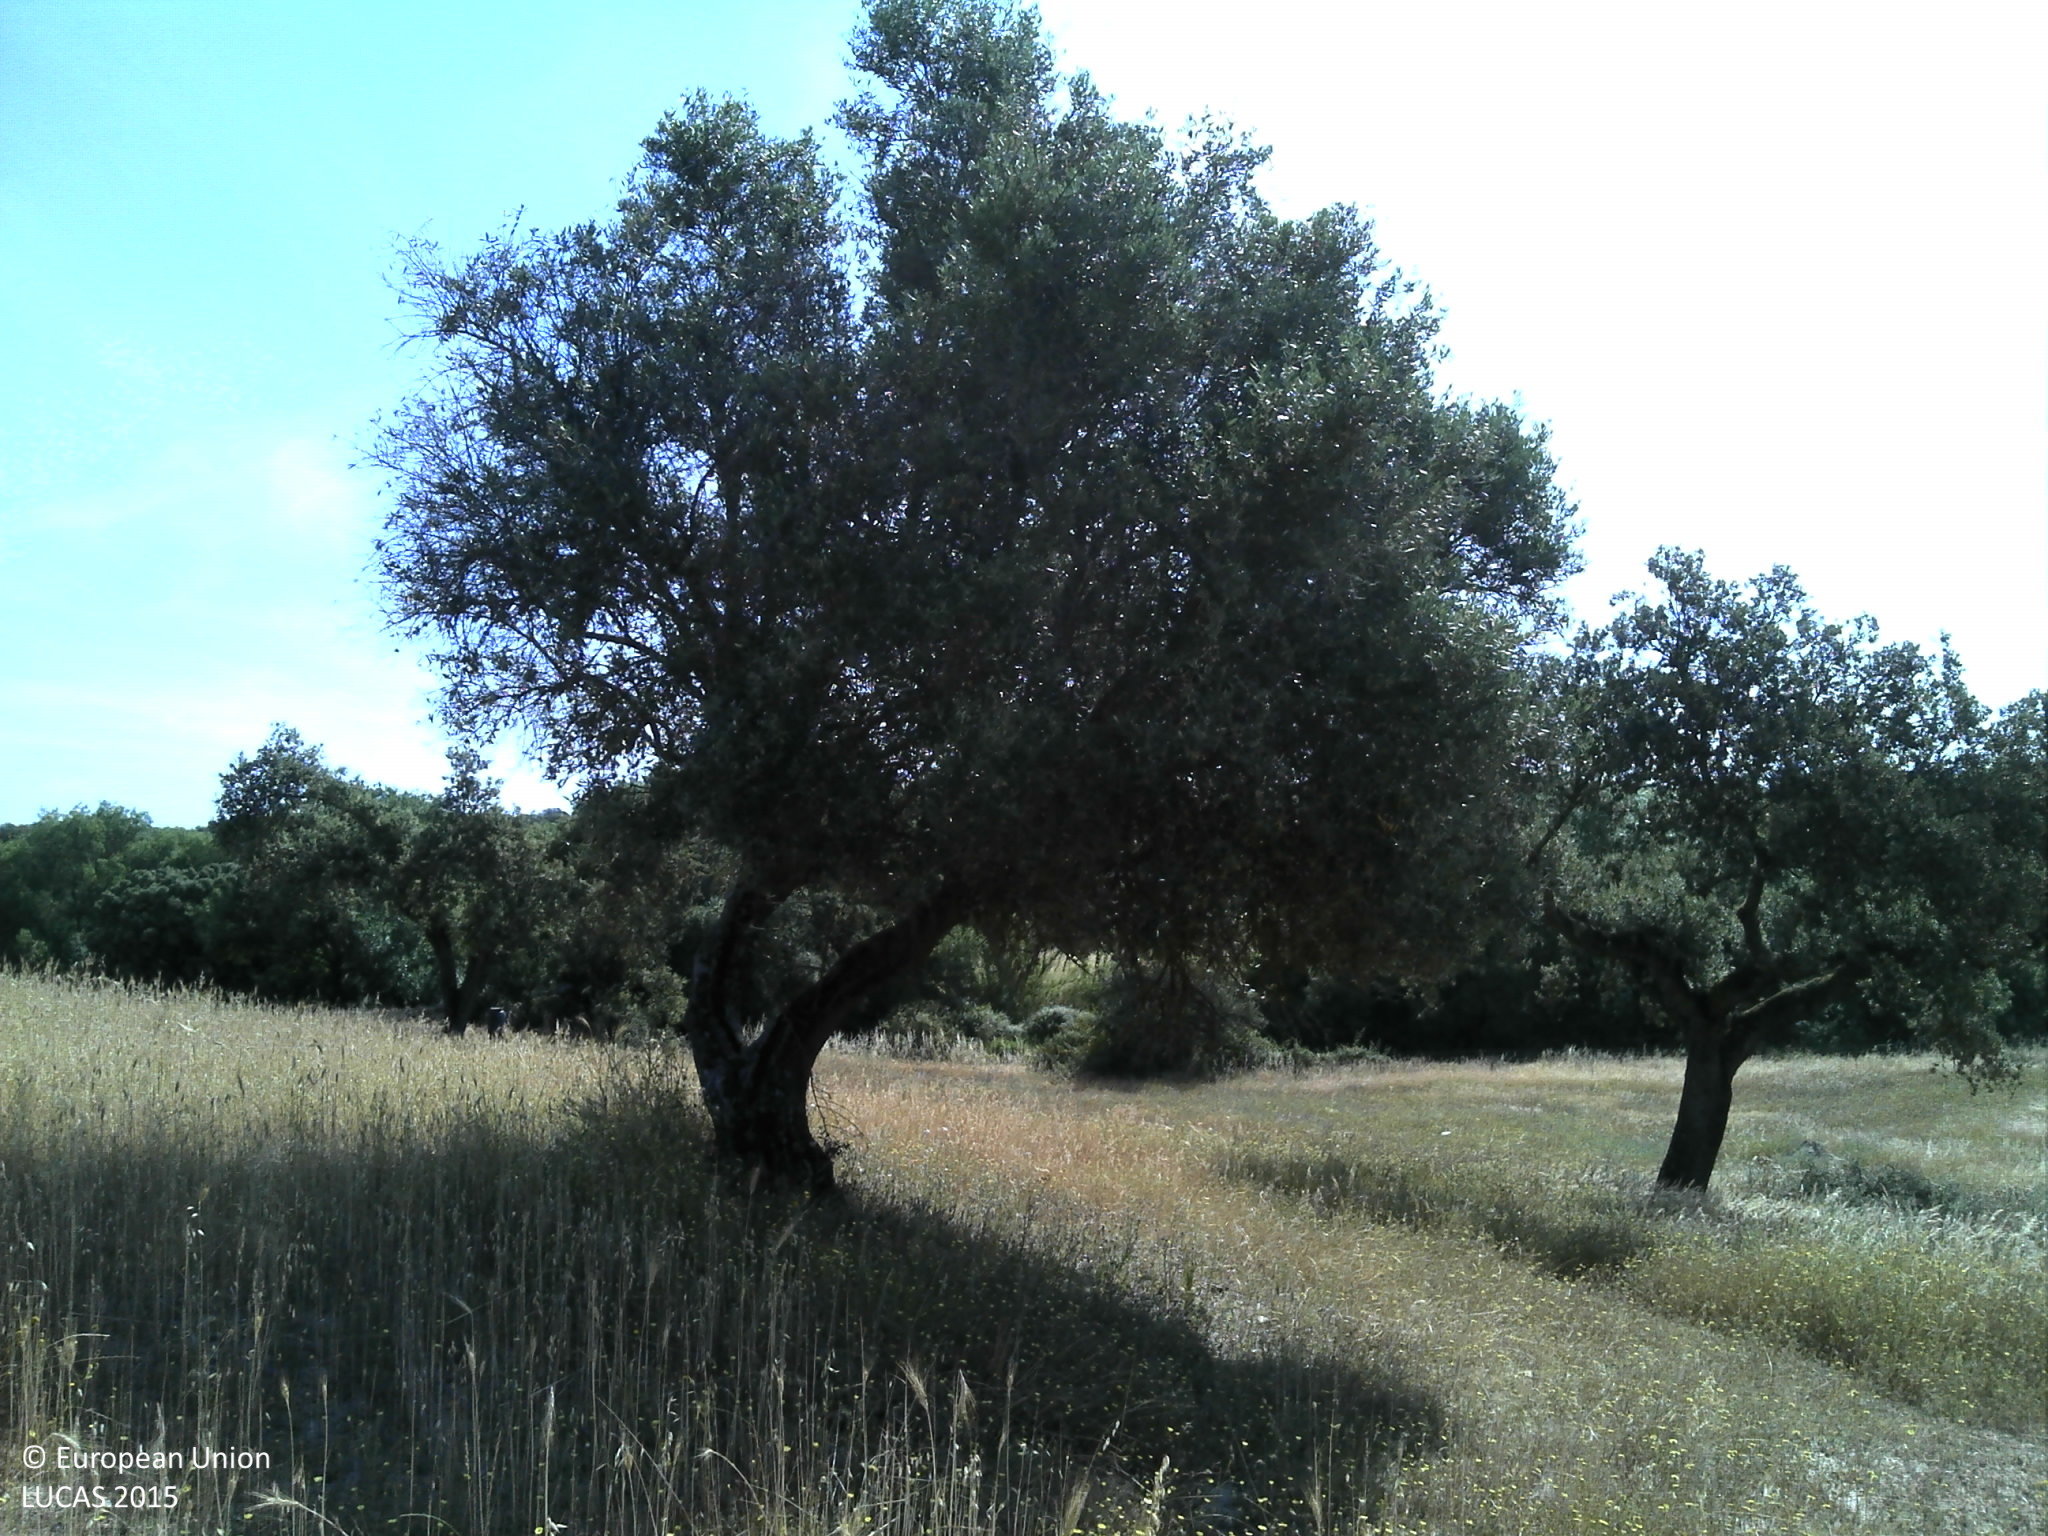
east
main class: Cropland
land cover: Olive groves
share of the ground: 10 - 25 %
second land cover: Triticale
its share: 10 - 25 %
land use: Agriculture (excluding fallow land and kitchen gardens)
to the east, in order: Olive groves; Triticale; Broadleaved woodland; Grassland without tree/shrub cover; Fences; Spontaneously vegetated surfaces; Broadleaved woodland; Rivers and streams; Broadleaved woodland; Spontaneously vegetated surfaces; Fences; Broadleaved woodland
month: May
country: PT
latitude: 39.0512
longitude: -7.5930
